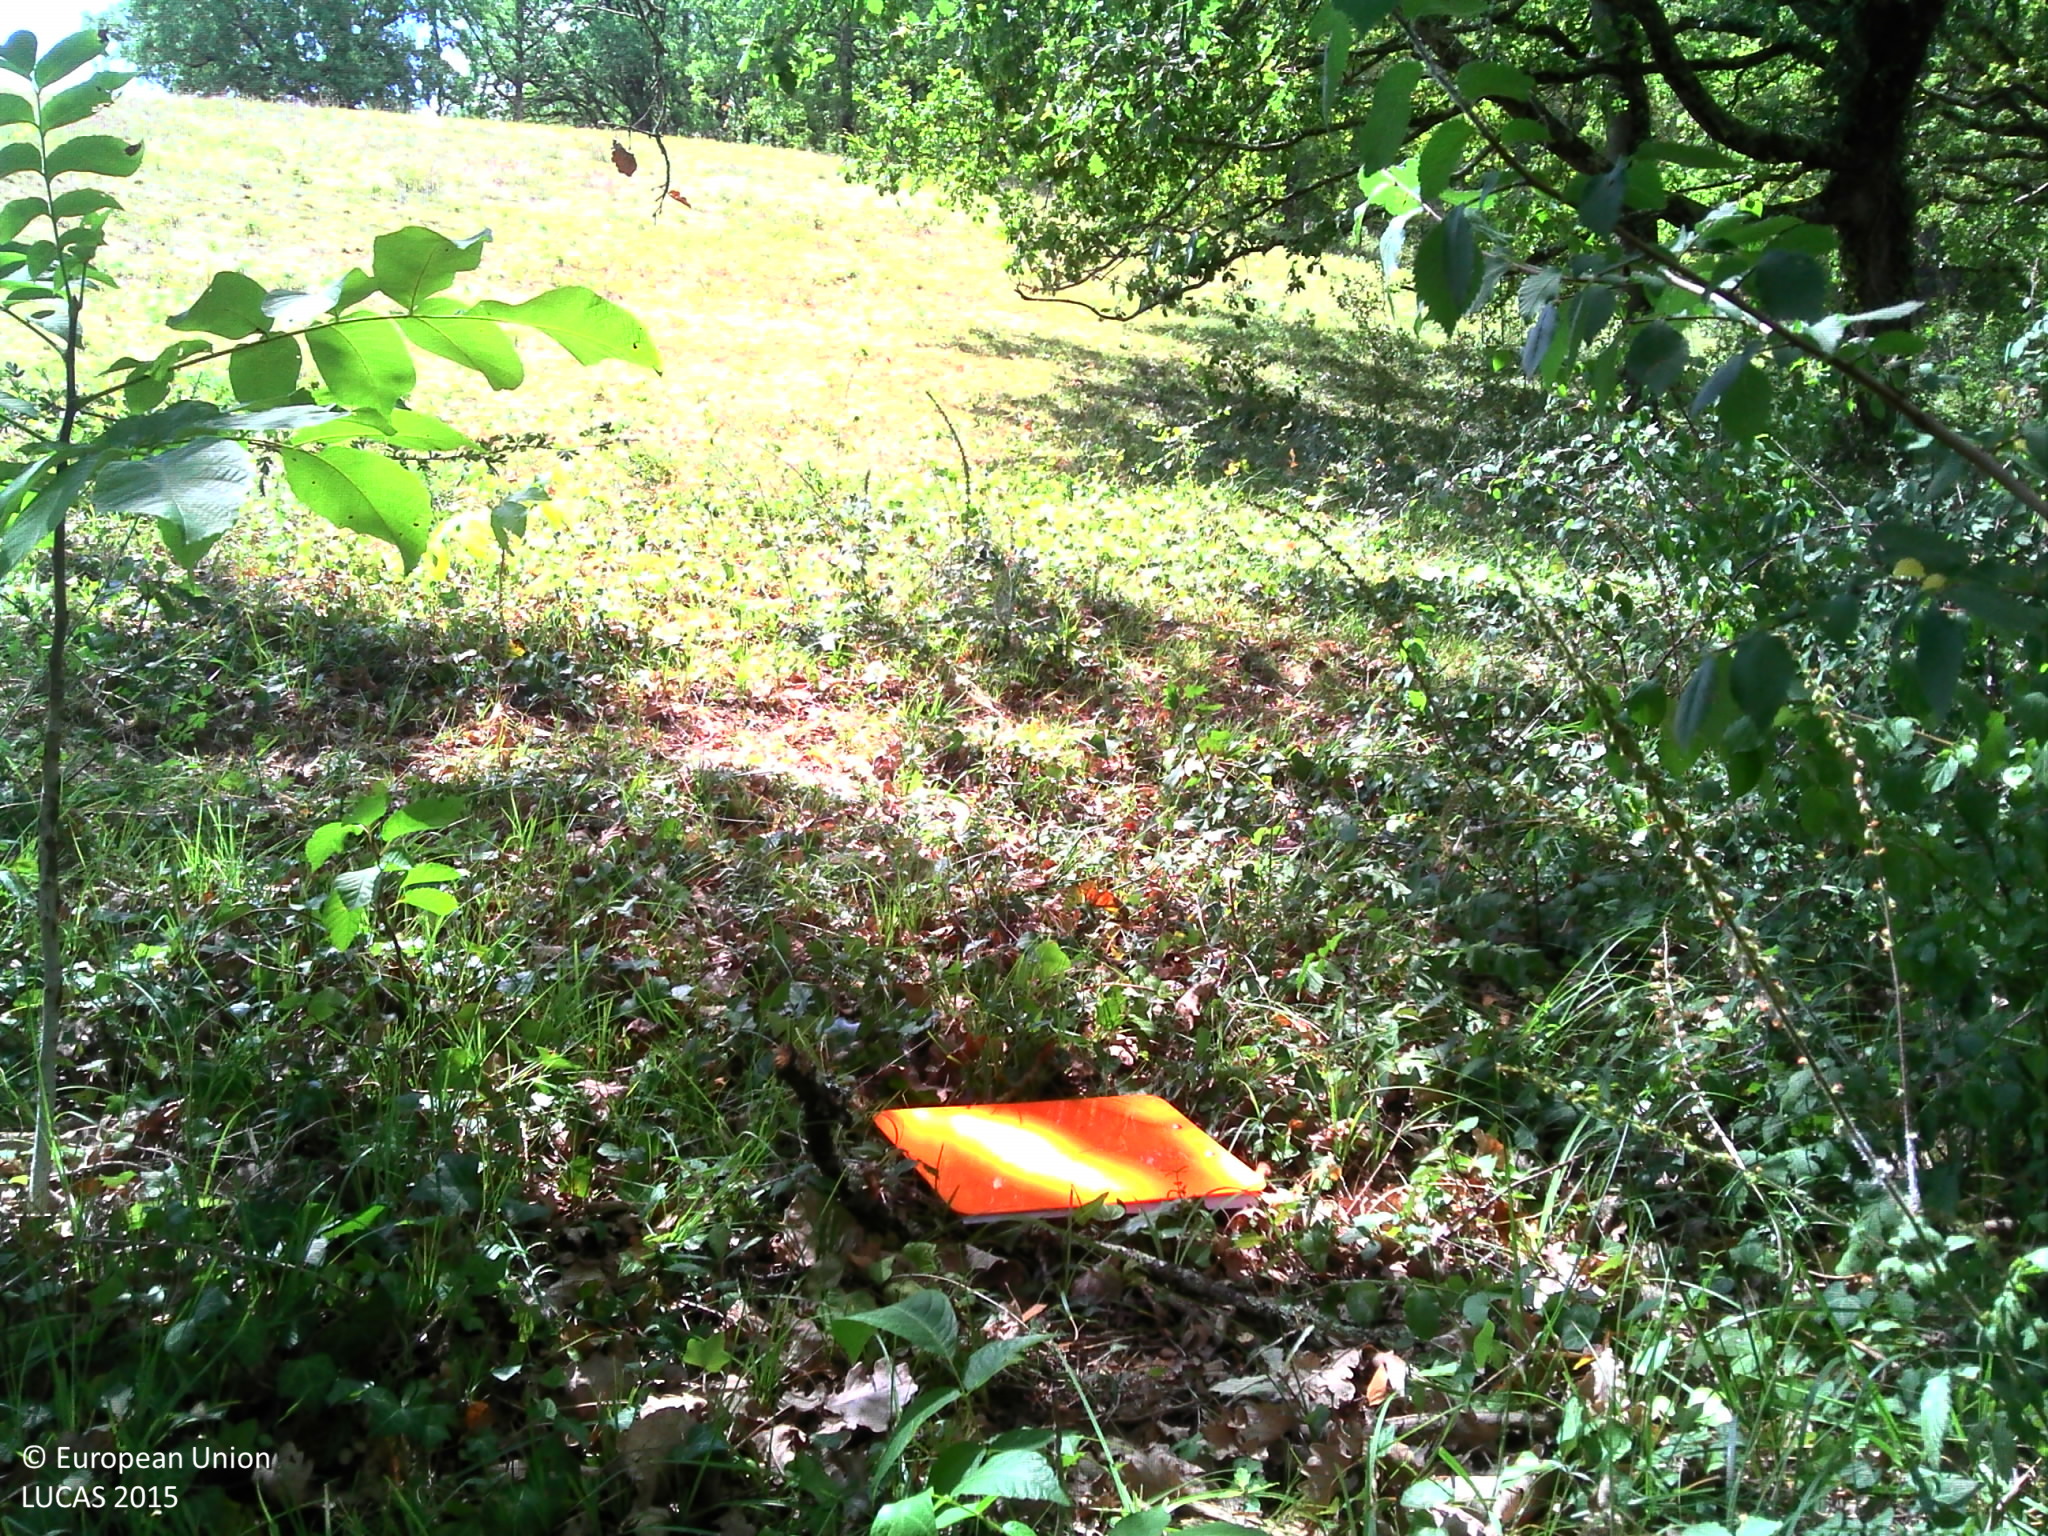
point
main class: Woodland
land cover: Broadleaved woodland
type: thermophilous deciduous forest
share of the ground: > 75 %
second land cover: Grassland without tree/shrub cover
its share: > 75 %
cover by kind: broadleaved forest trees 65 %, herbaceous plants 35 %
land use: Forestry
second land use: Agriculture (excluding fallow land and kitchen gardens)
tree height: > 5 m
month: July
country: FR
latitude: 44.3738
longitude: 0.5684
